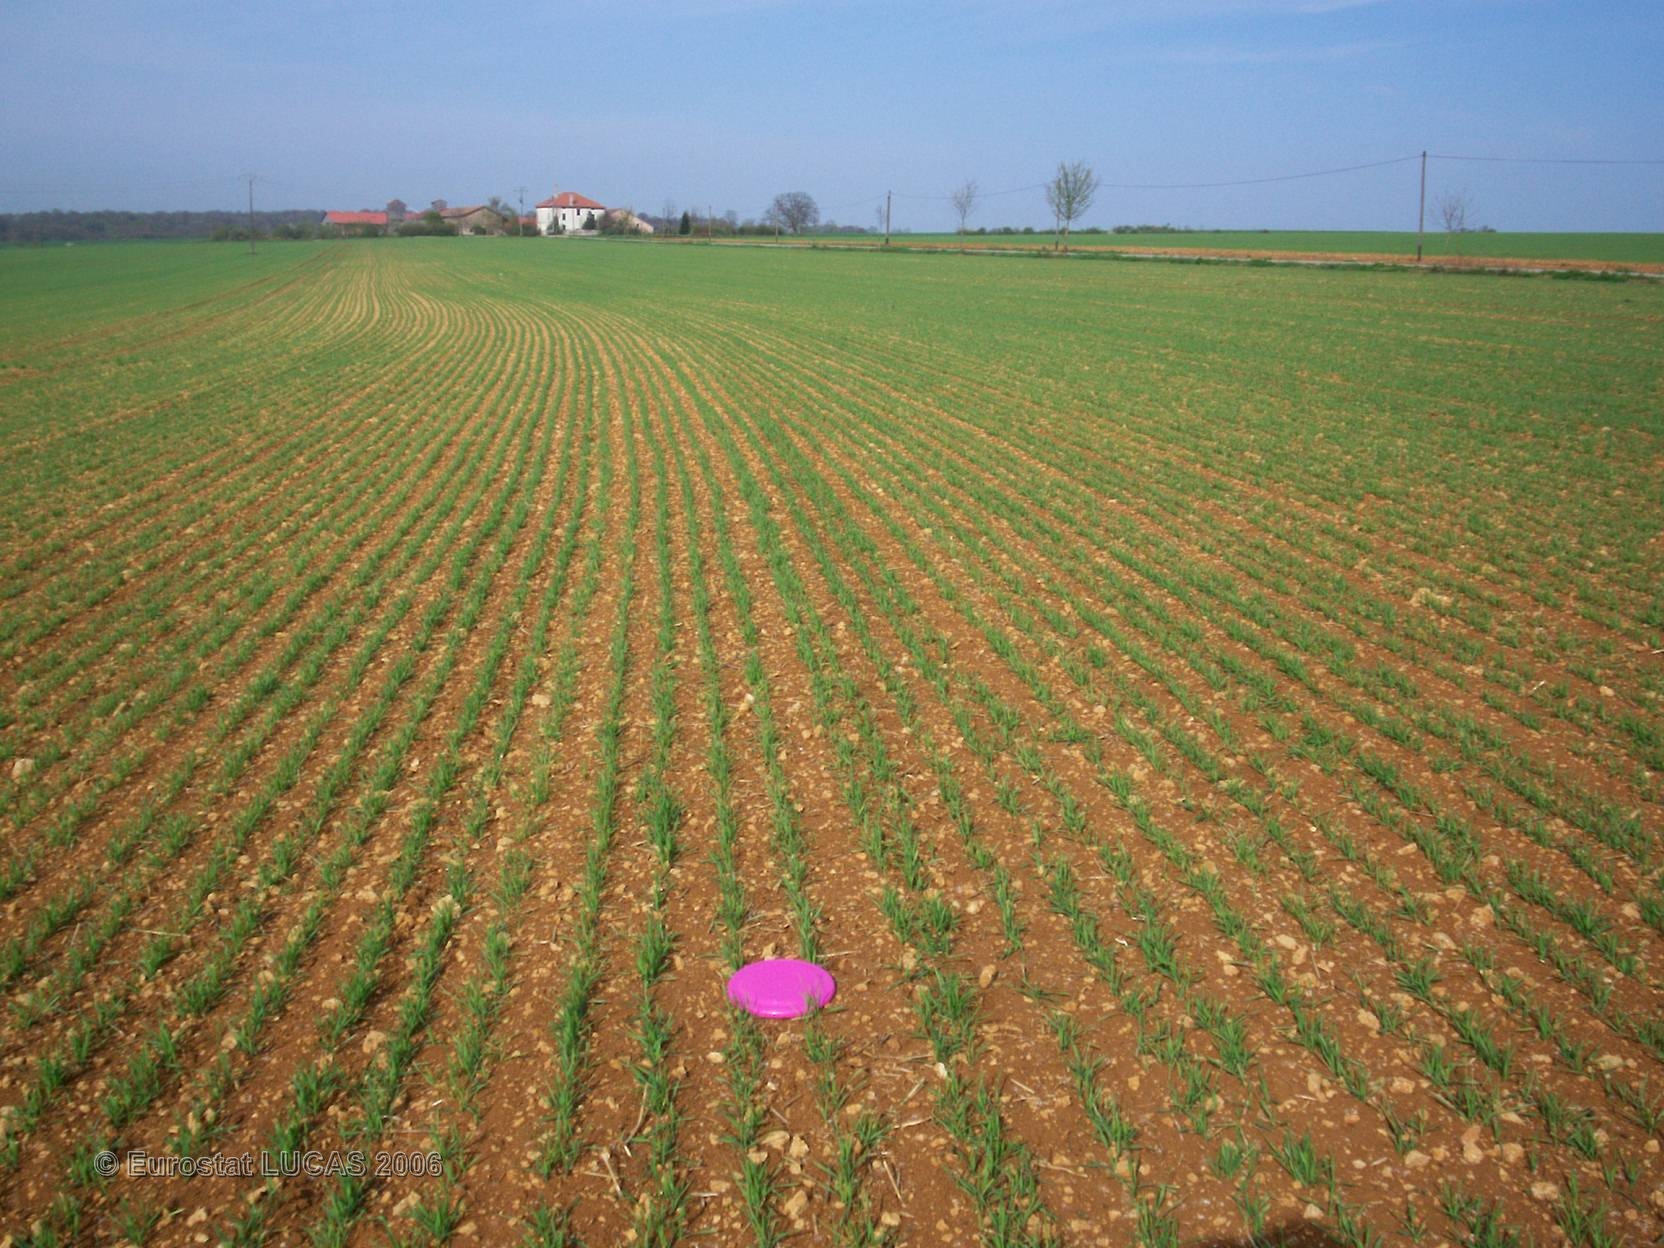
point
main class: Cropland
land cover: Barley
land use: Agriculture (excluding fallow land and kitchen gardens)
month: April
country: FR
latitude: 48.9037
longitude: 5.8931
